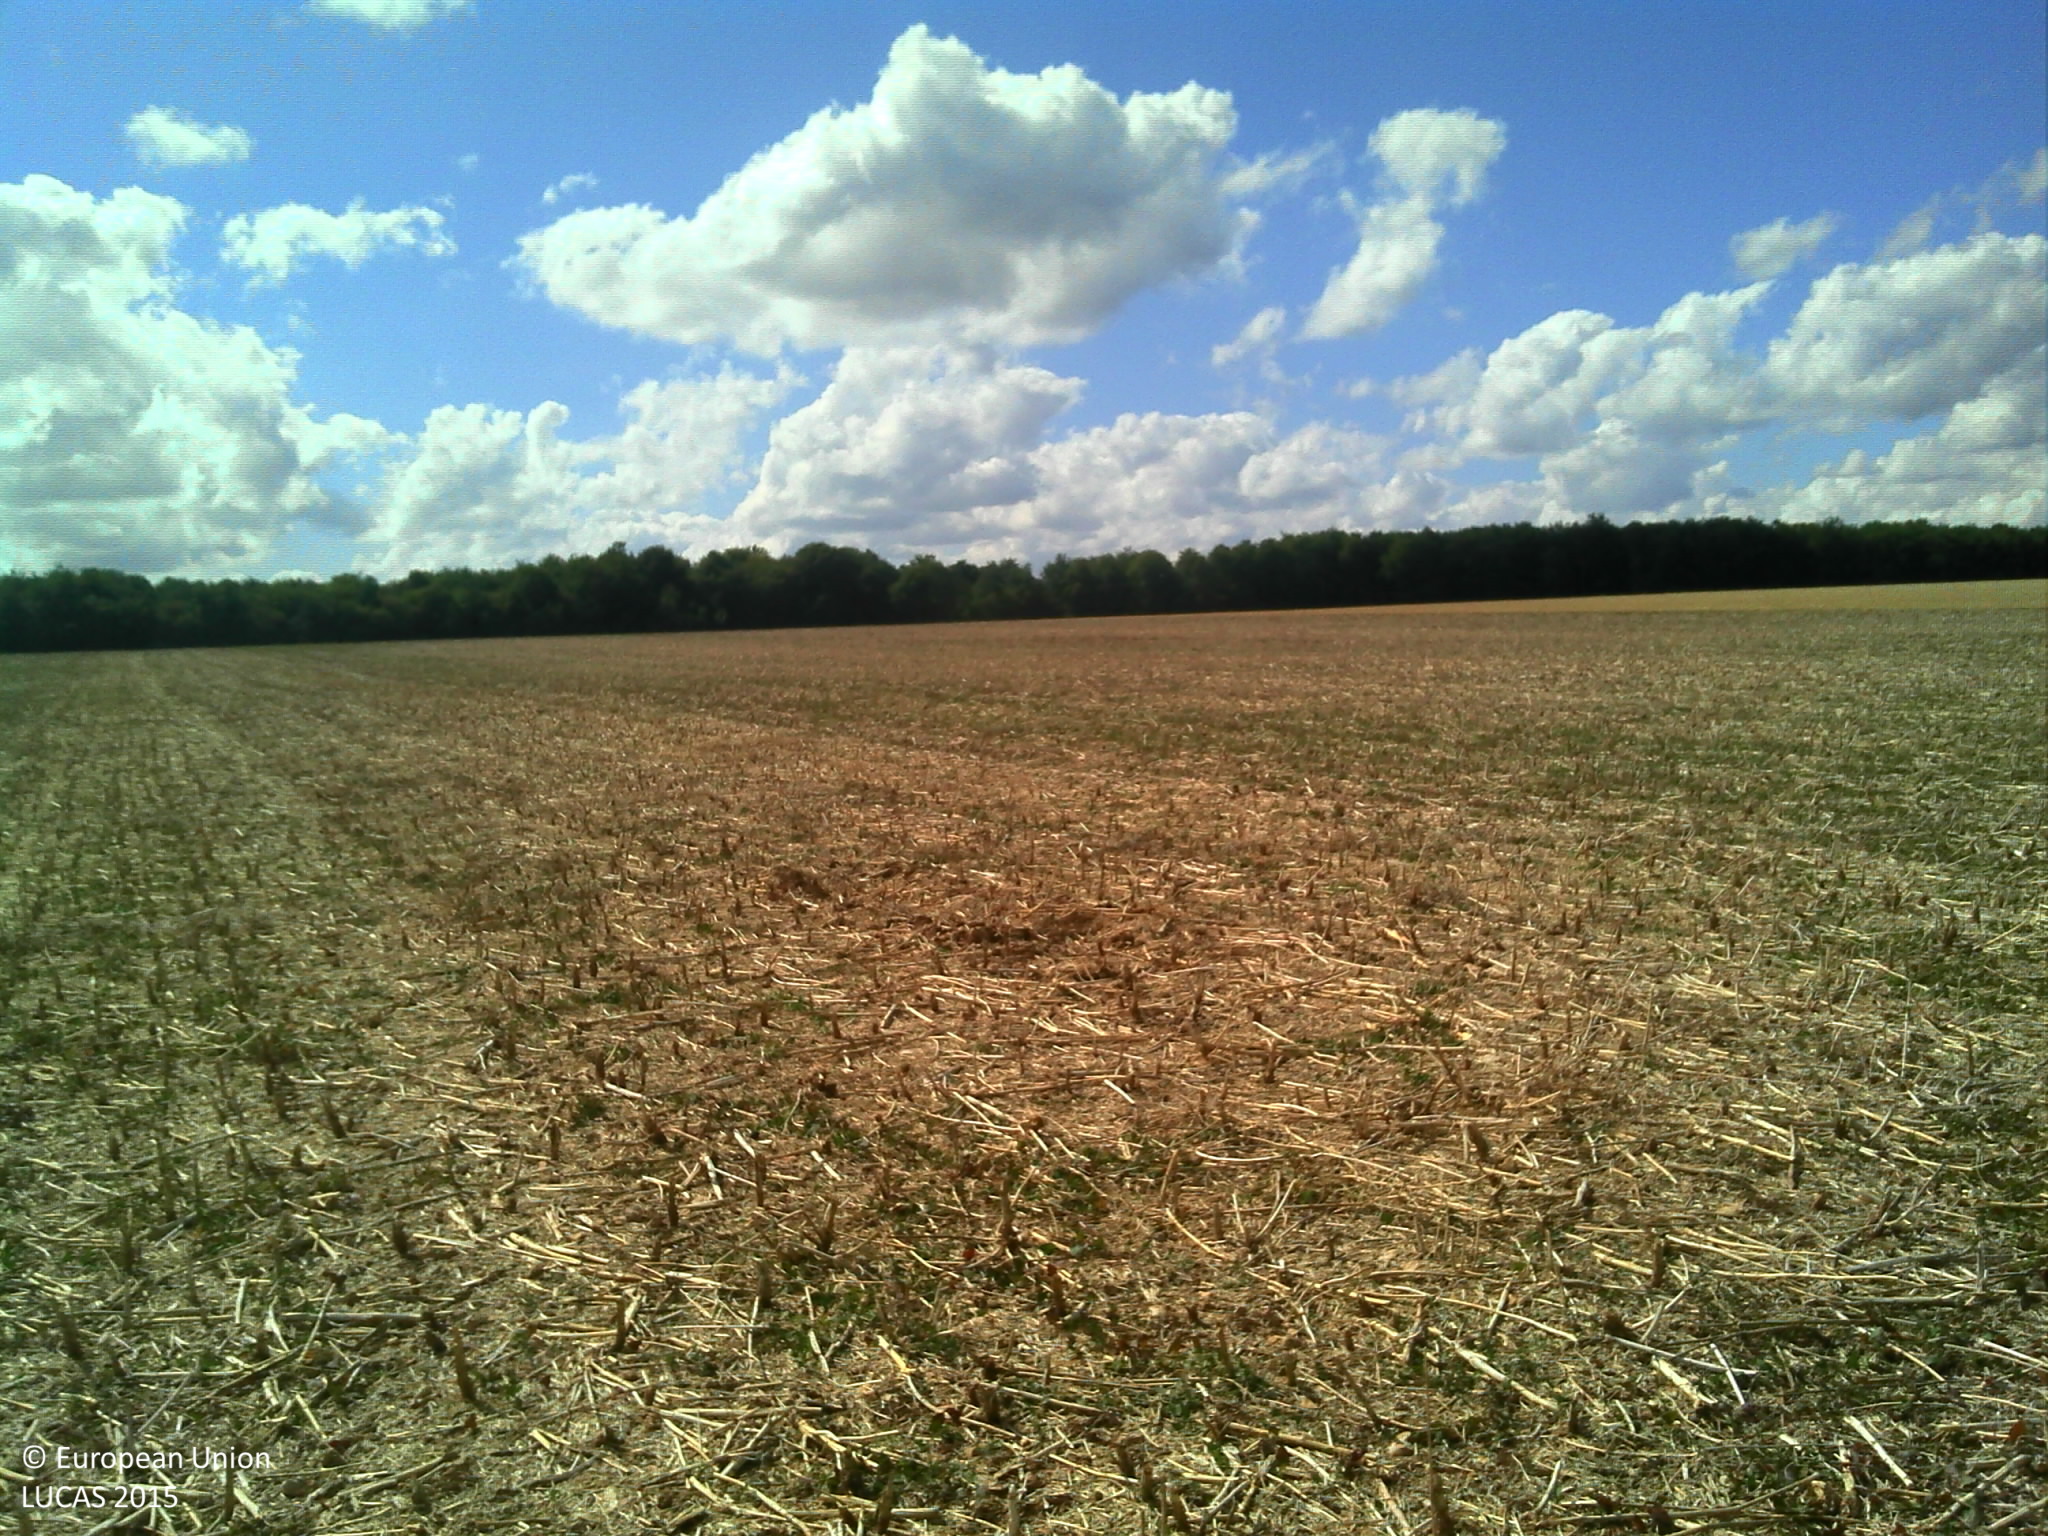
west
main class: Cropland
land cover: Rape and turnip rape
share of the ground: 10 - 25 %
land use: Agriculture (excluding fallow land and kitchen gardens)
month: August
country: FR
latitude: 47.7686
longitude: 5.0226
